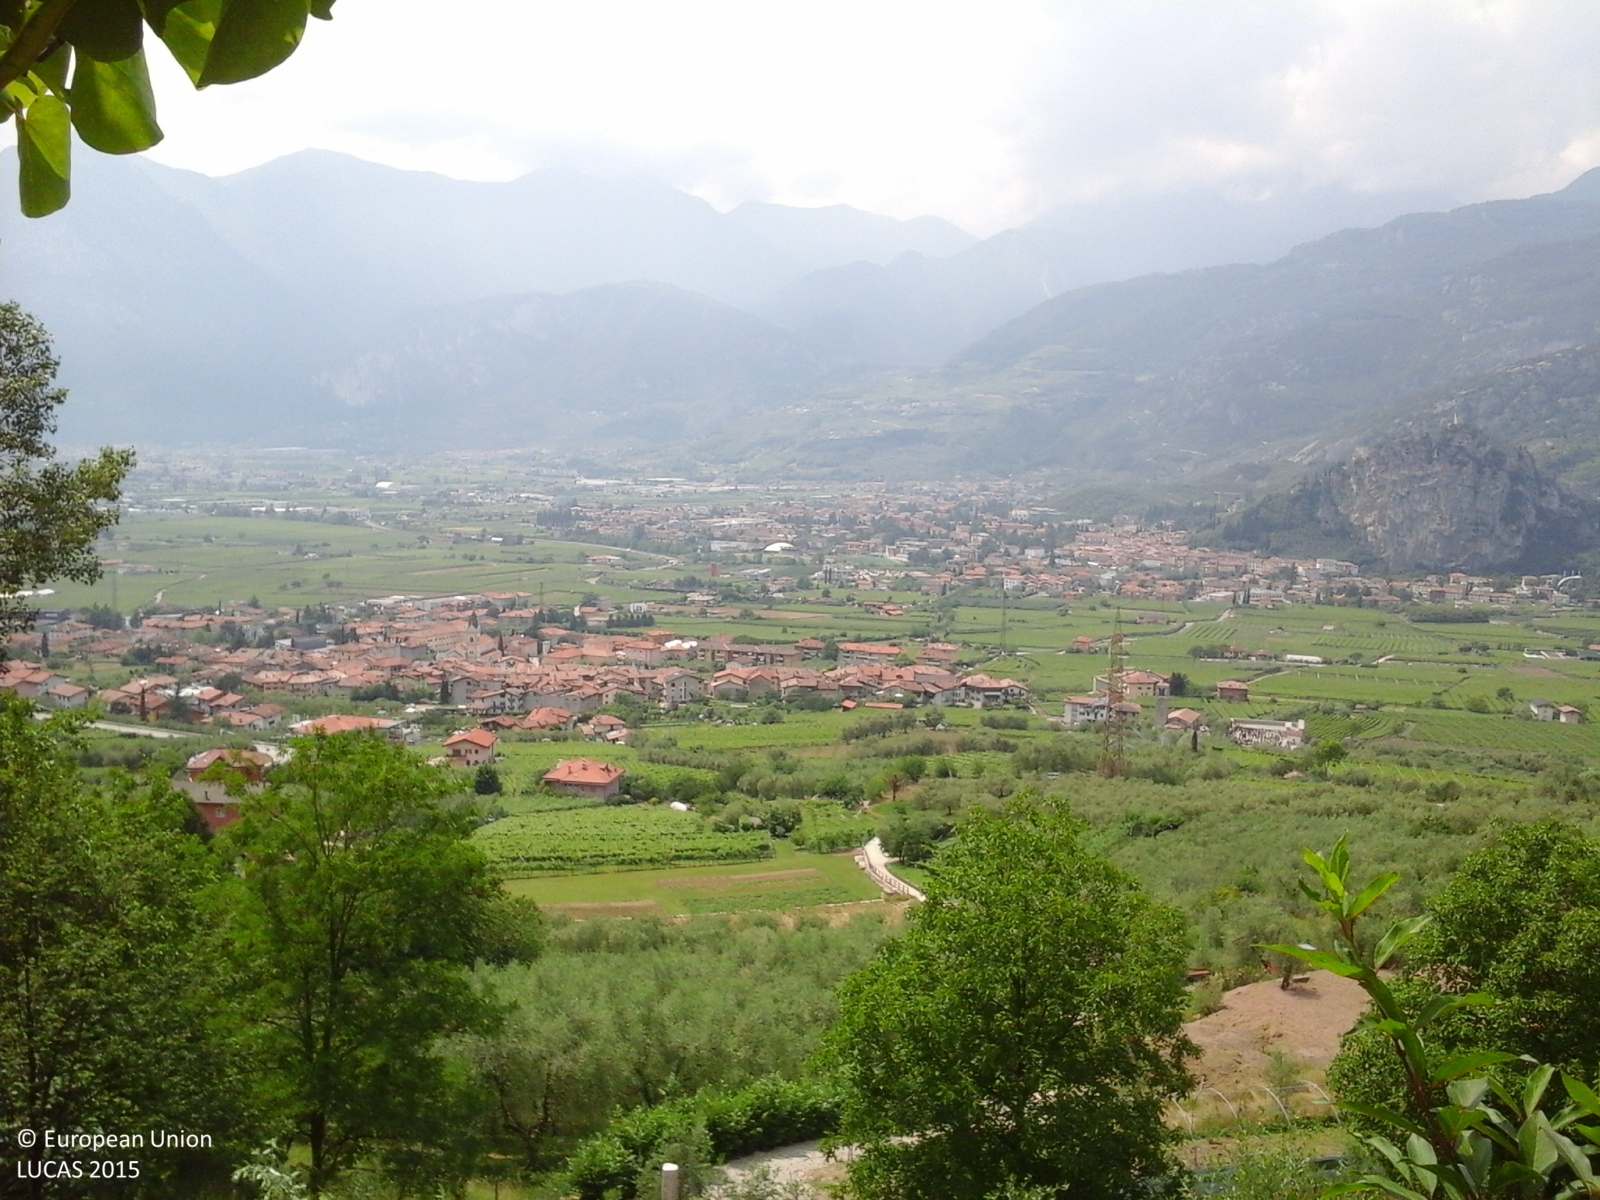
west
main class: Cropland
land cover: Olive groves
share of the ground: 50 - 75 %
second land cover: Grassland without tree/shrub cover
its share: > 75 %
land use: Agriculture (excluding fallow land and kitchen gardens)
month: June
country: IT
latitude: 45.9149
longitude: 10.9140
